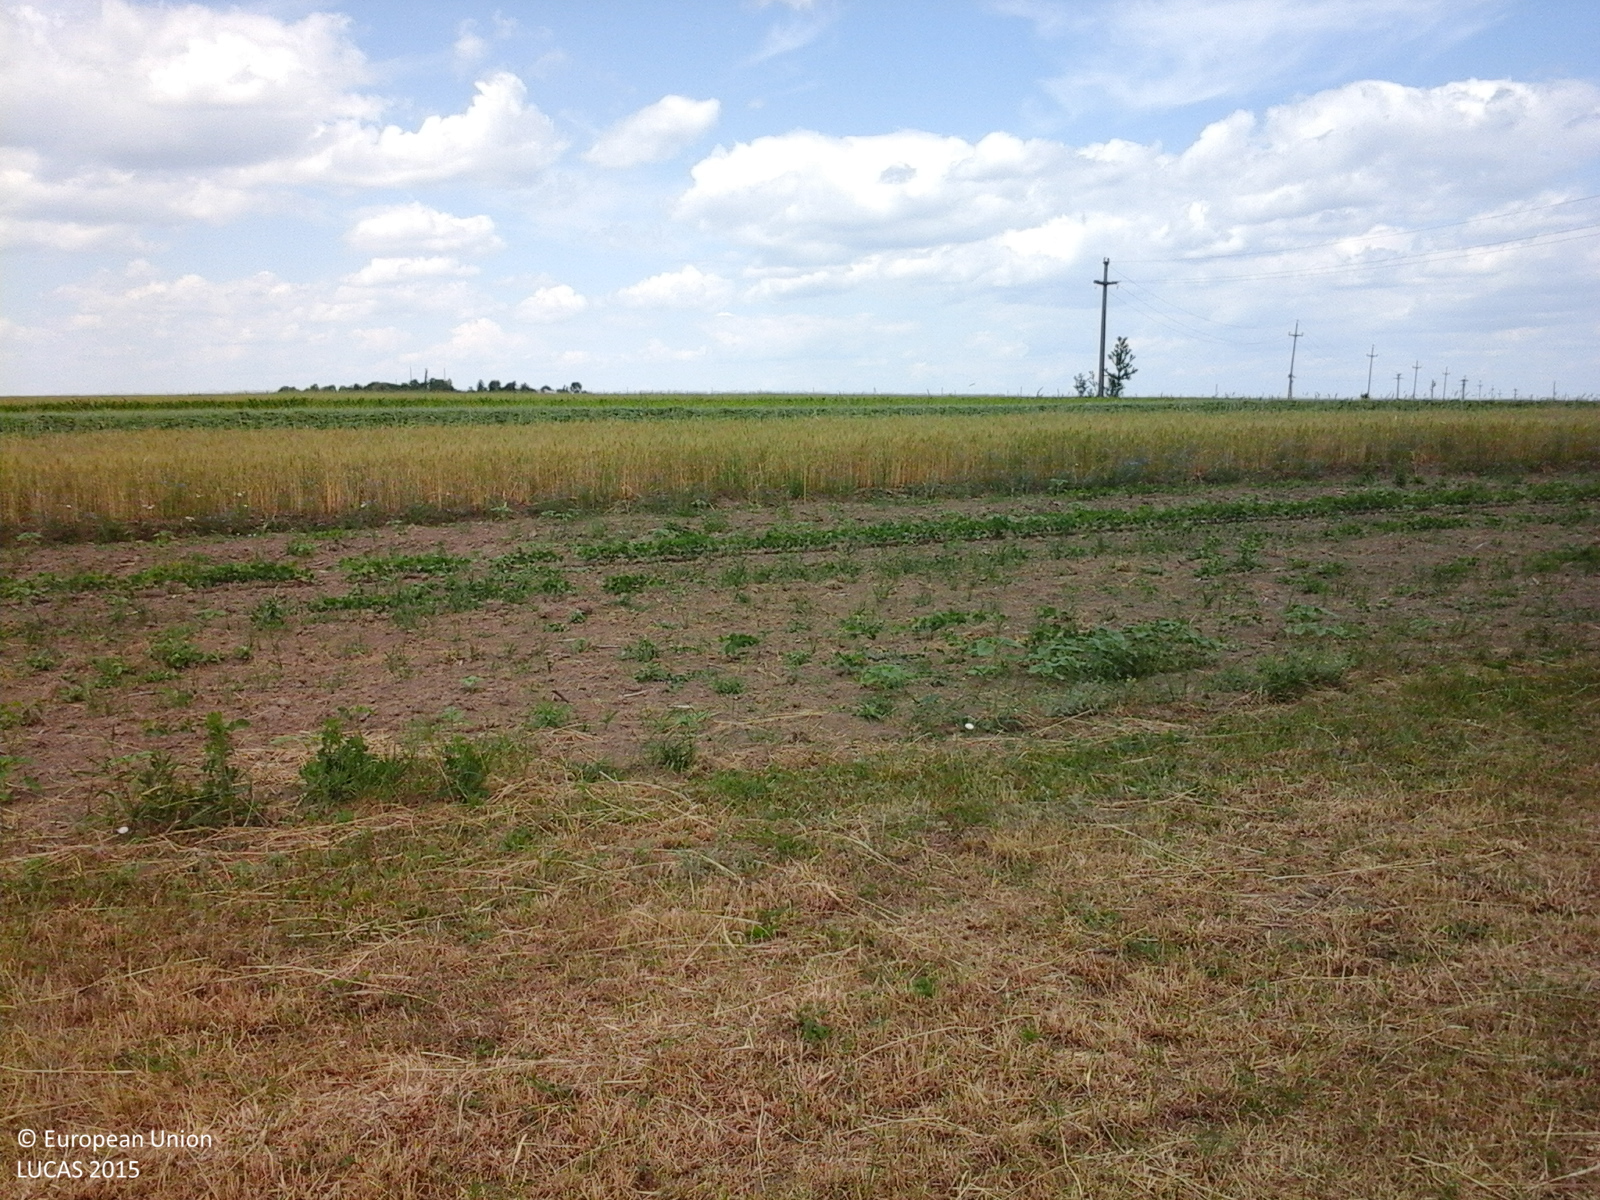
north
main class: Grassland
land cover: Grassland without tree/shrub cover
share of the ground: > 75 %
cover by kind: herbaceous plants 100 %
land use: Agriculture (excluding fallow land and kitchen gardens)
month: June
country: RO
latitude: 47.6675
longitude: 26.3738
